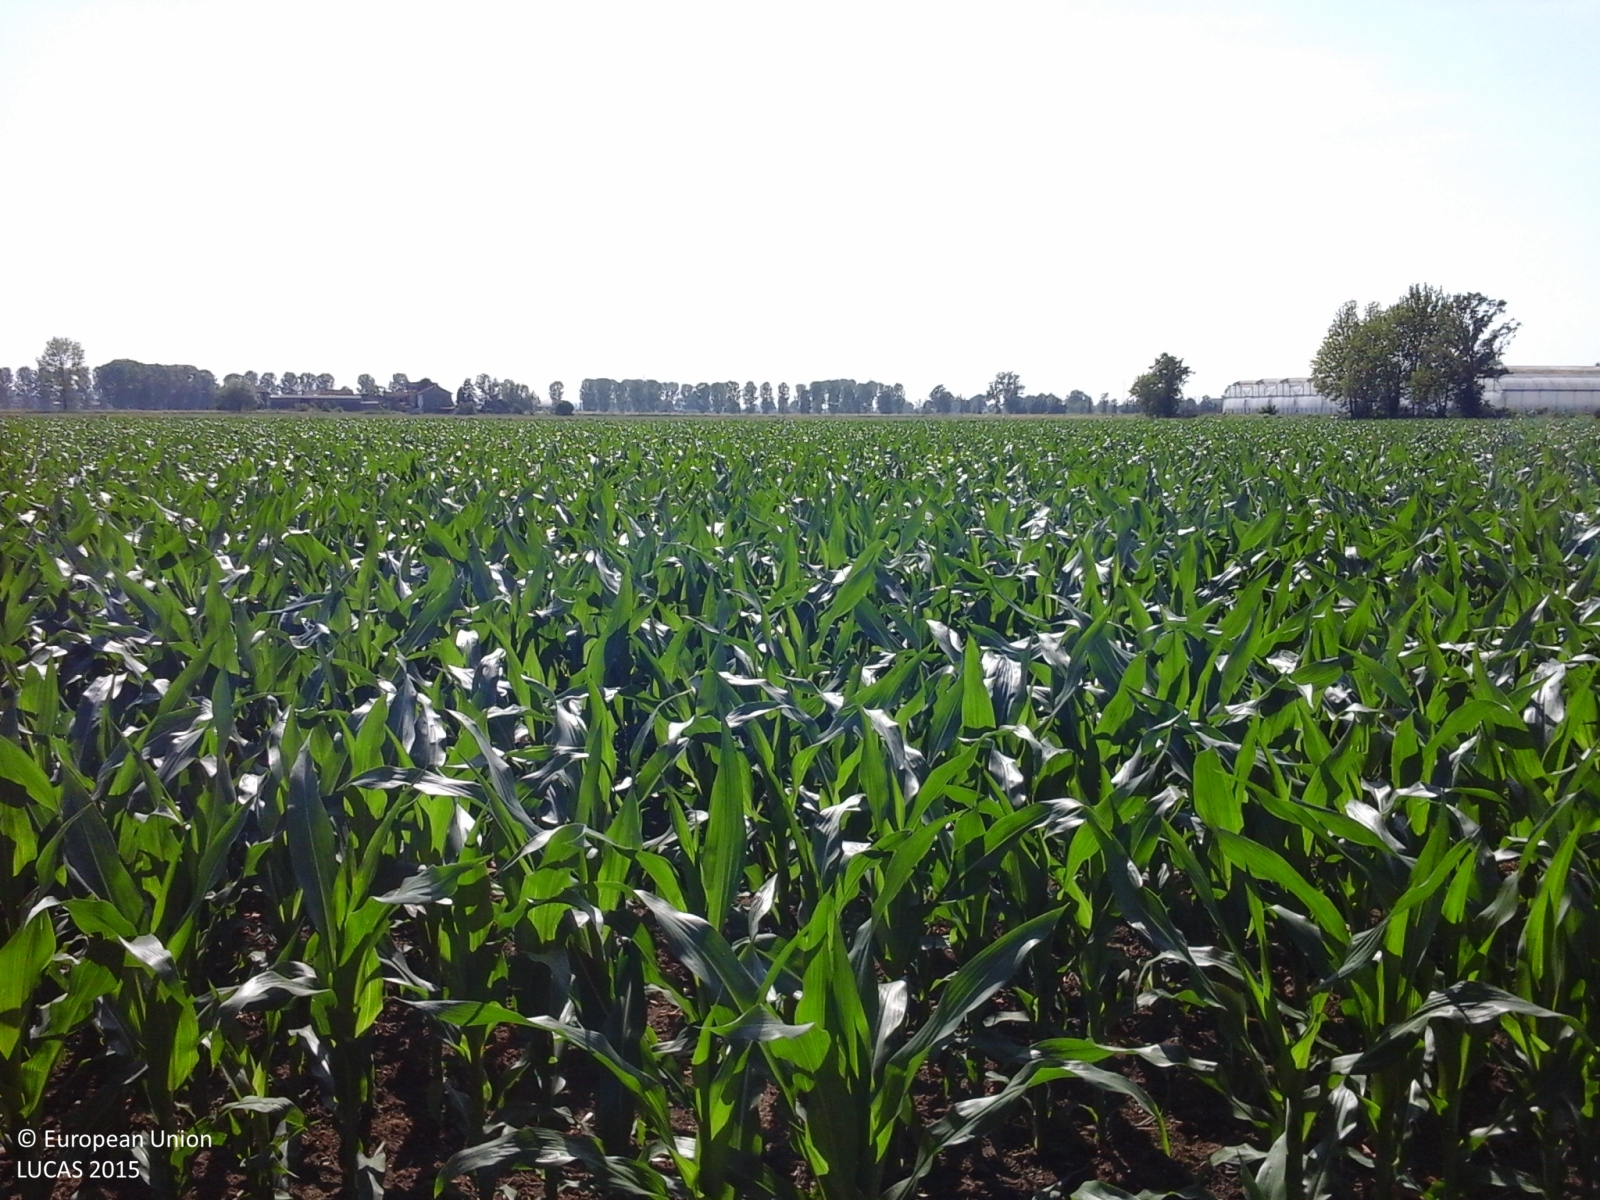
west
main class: Cropland
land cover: Maize
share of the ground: > 75 %
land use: Agriculture (excluding fallow land and kitchen gardens)
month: May
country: IT
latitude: 45.2151
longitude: 9.5552
